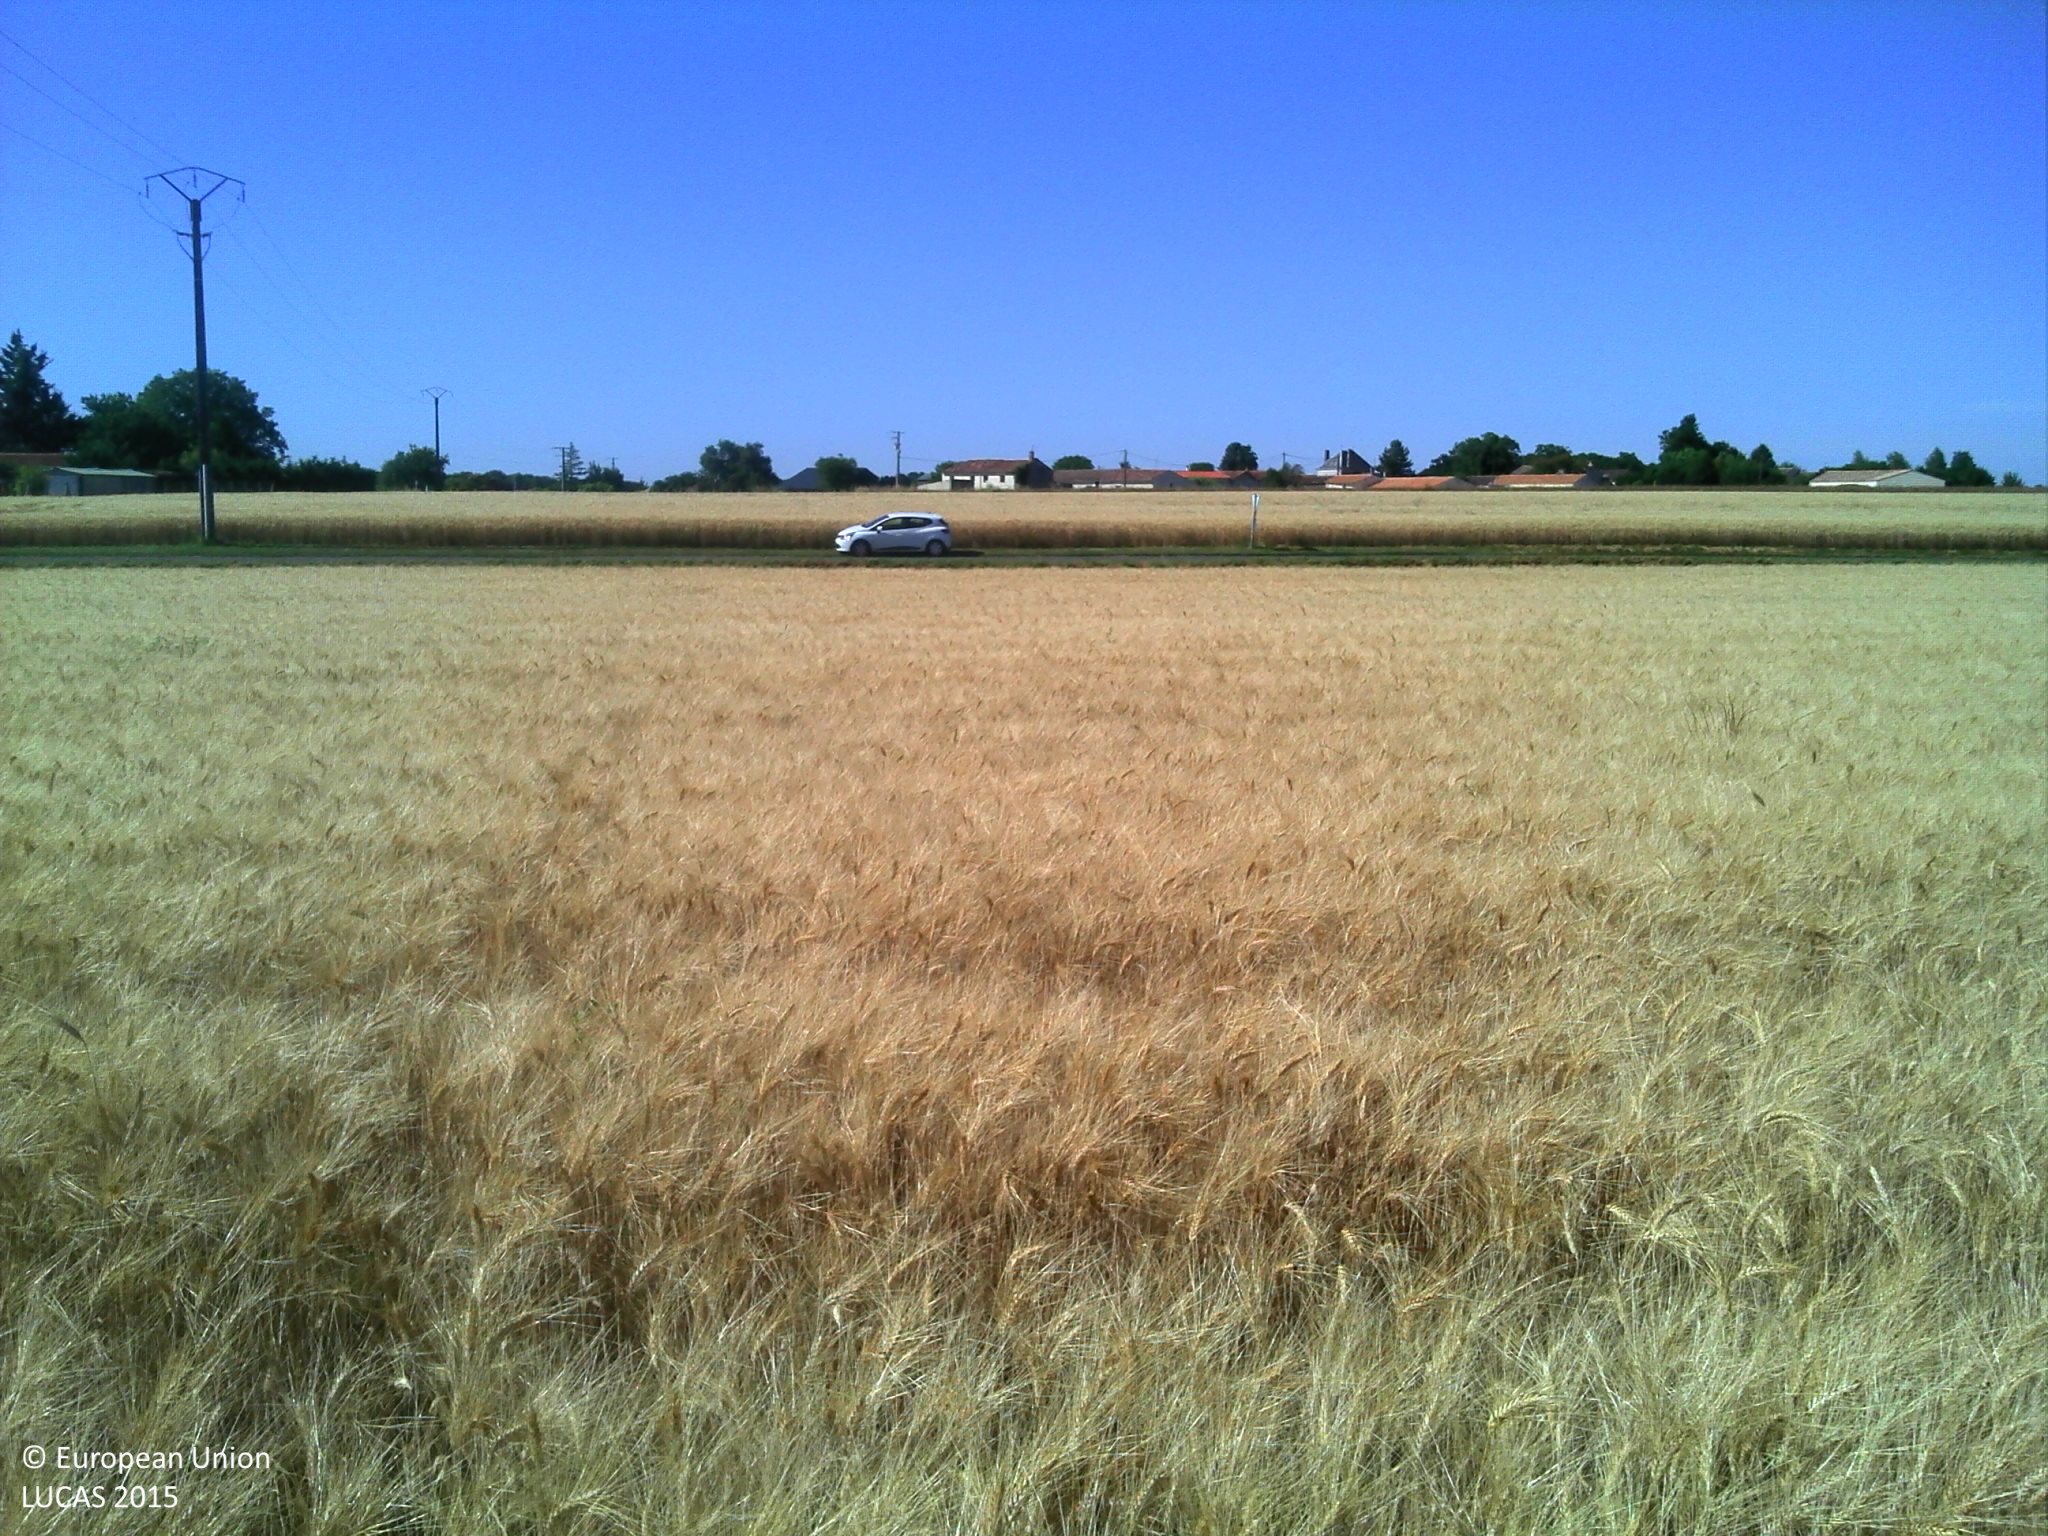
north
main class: Cropland
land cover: Durum wheat
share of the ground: > 75 %
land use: Agriculture (excluding fallow land and kitchen gardens)
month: June
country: FR
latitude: 45.5795
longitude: -0.6735
